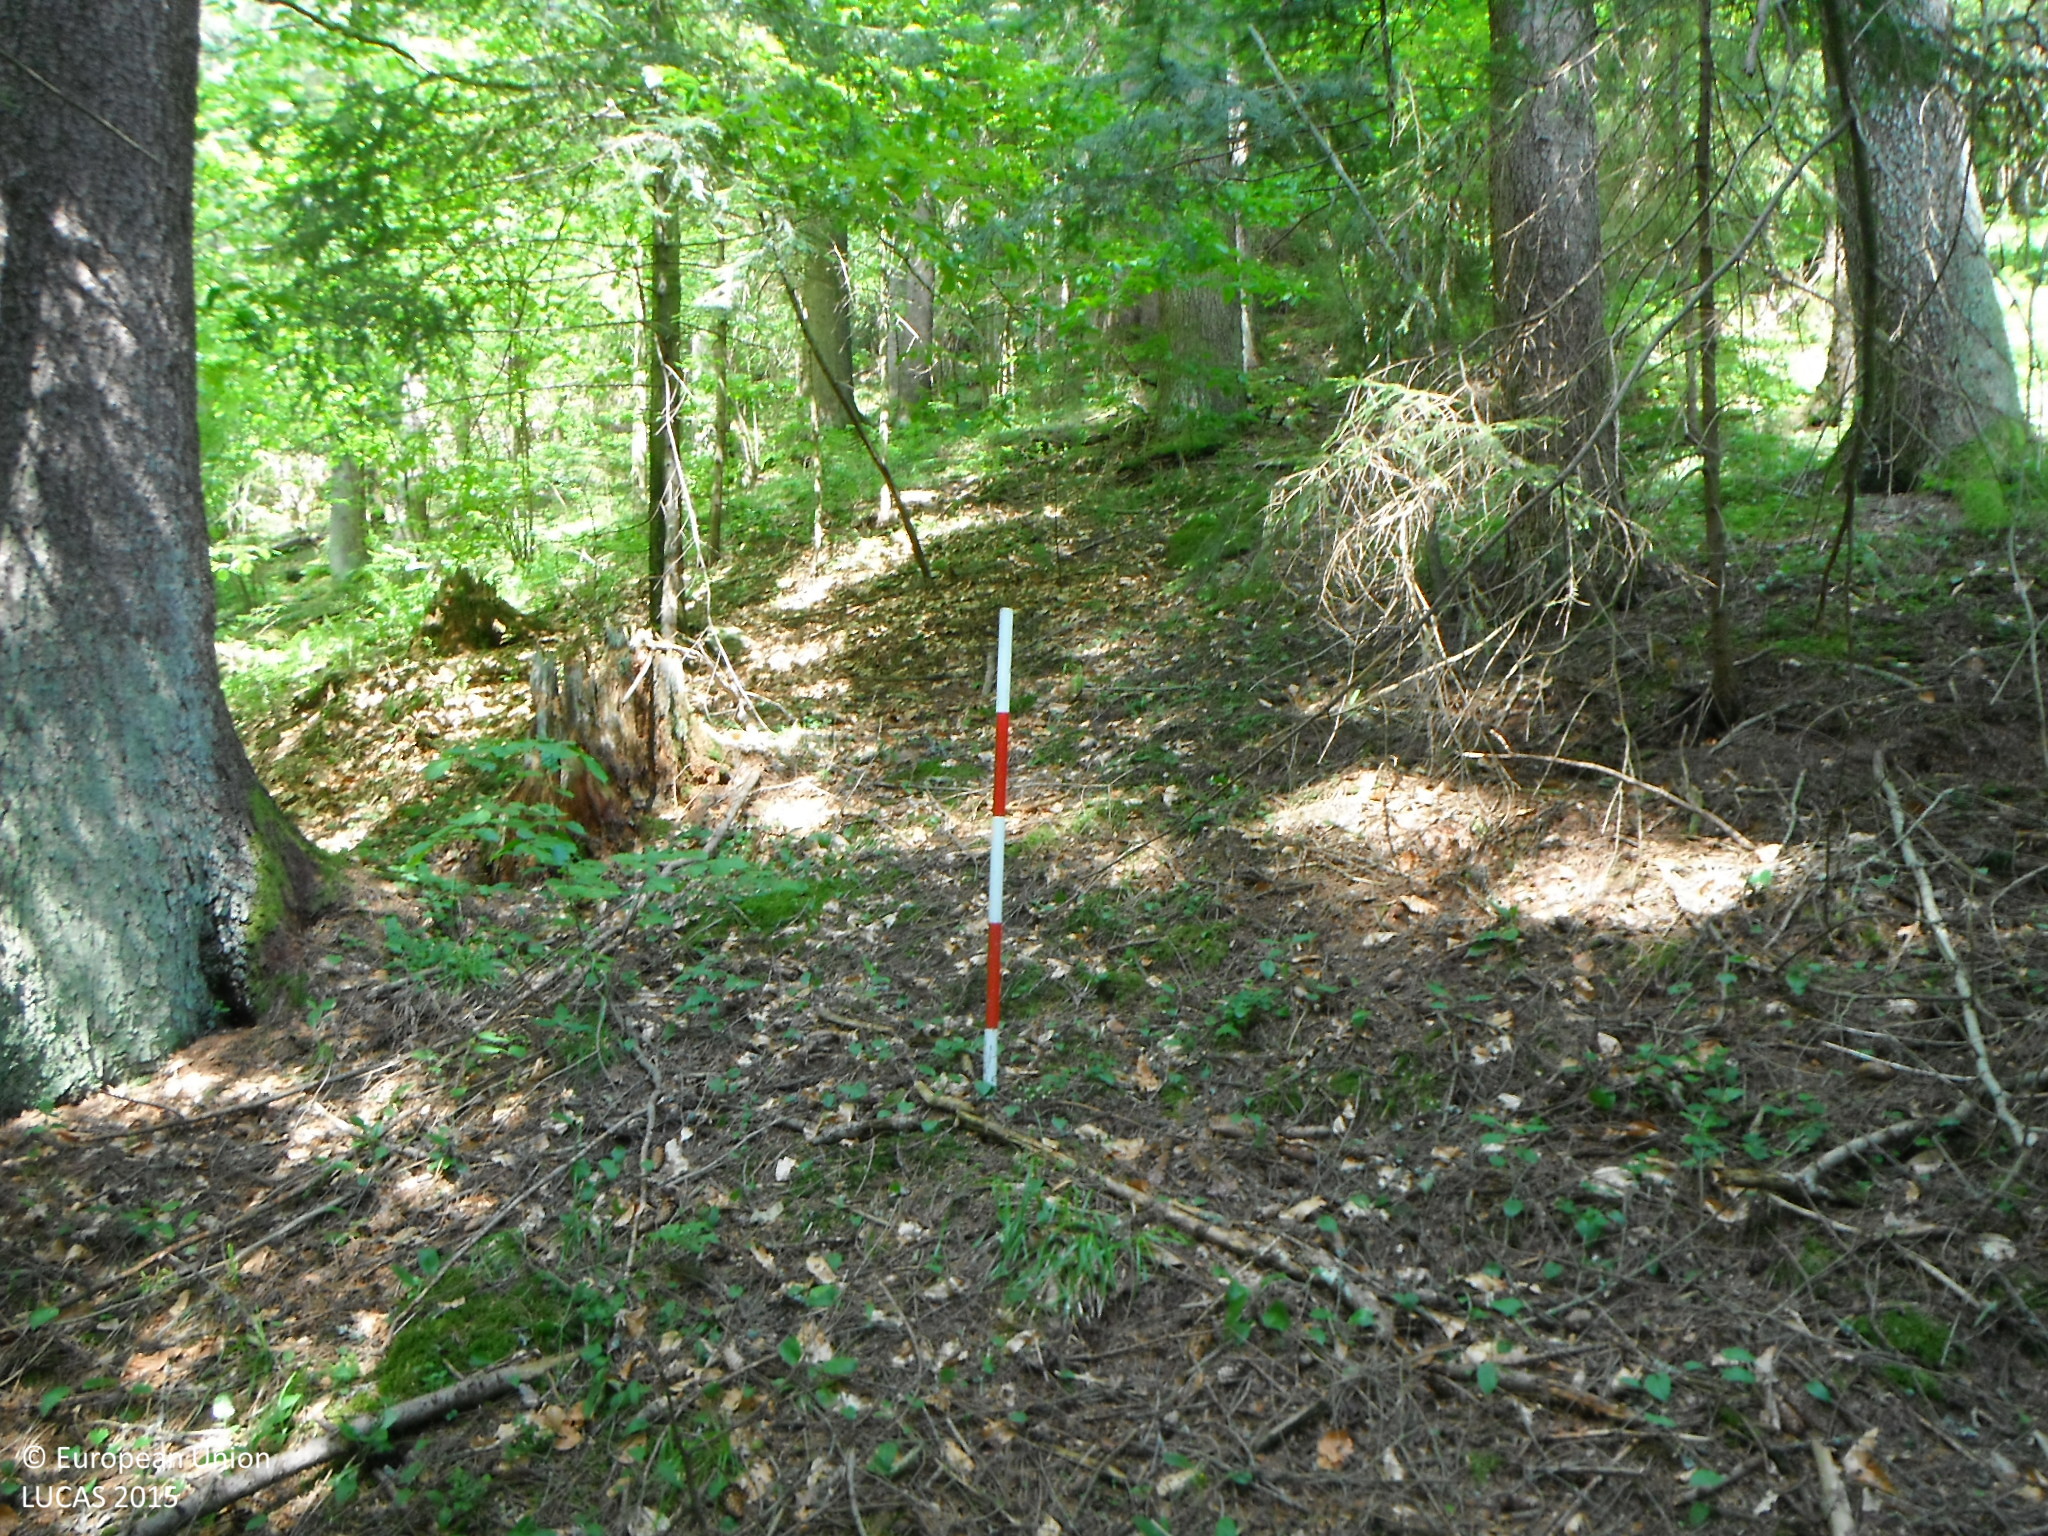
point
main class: Woodland
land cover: Spruce dominated coniferous woodland
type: alpine coniferous forest
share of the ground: > 75 %
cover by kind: coniferous forest trees 90 %, broadleaved forest trees 10 %
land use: Forestry
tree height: > 5 m
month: June
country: SK
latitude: 48.7826
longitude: 19.5939
